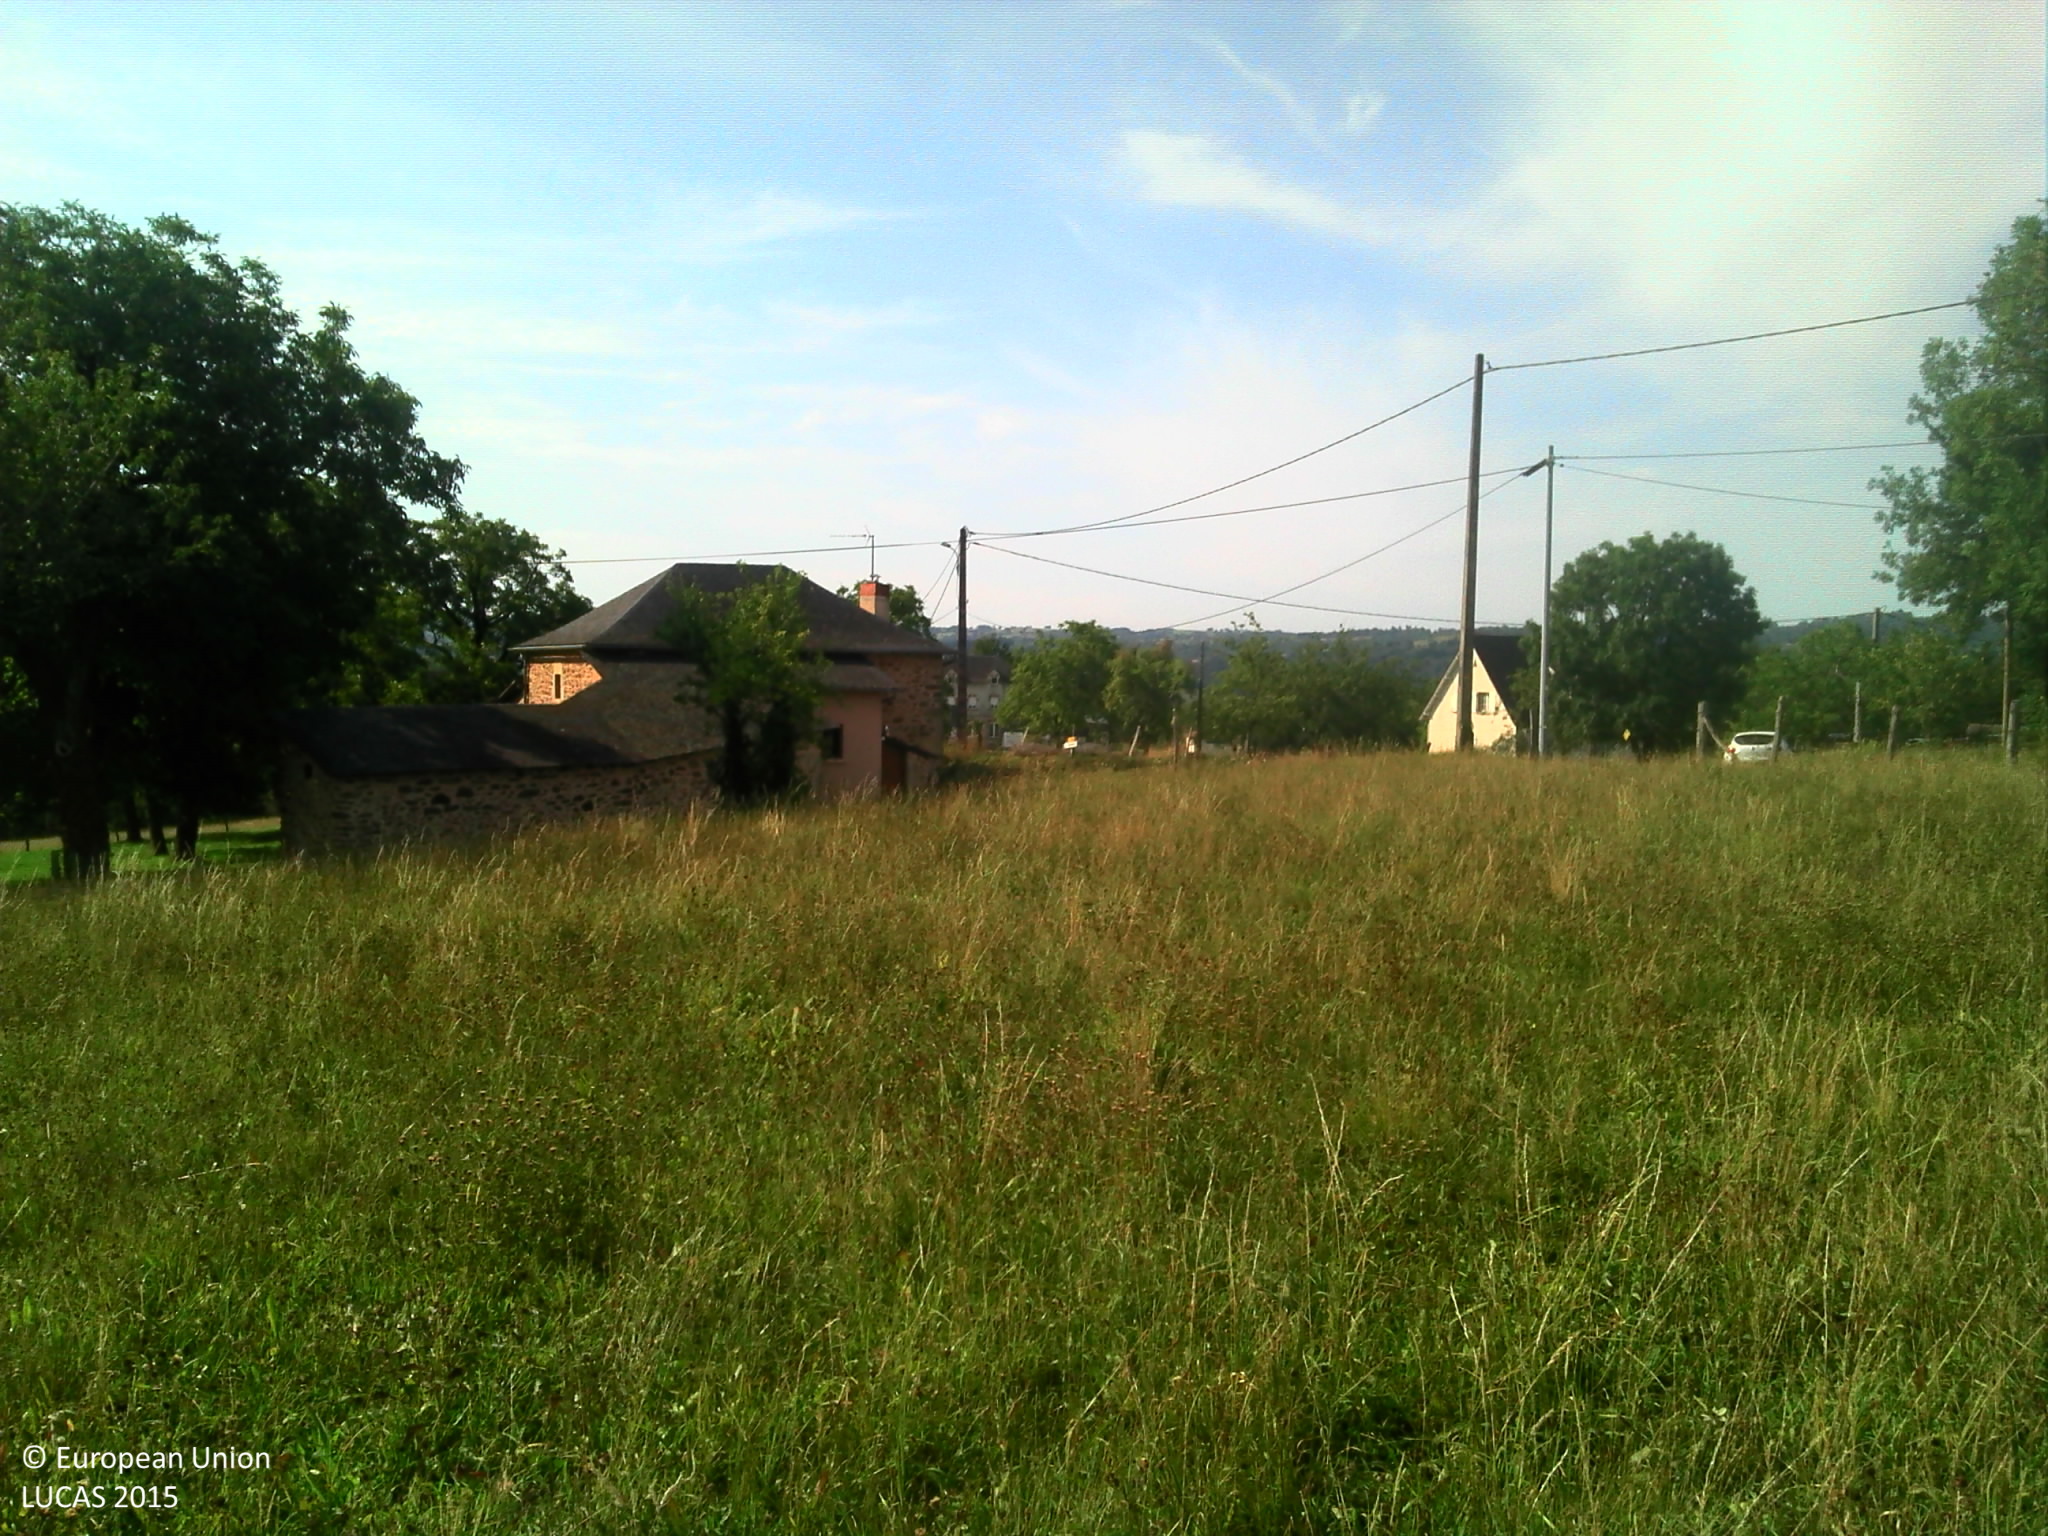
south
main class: Grassland
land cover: Grassland without tree/shrub cover
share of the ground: > 75 %
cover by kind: herbaceous plants 100 %
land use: Agriculture (excluding fallow land and kitchen gardens)
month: August
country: FR
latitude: 44.8178
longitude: 1.9689
